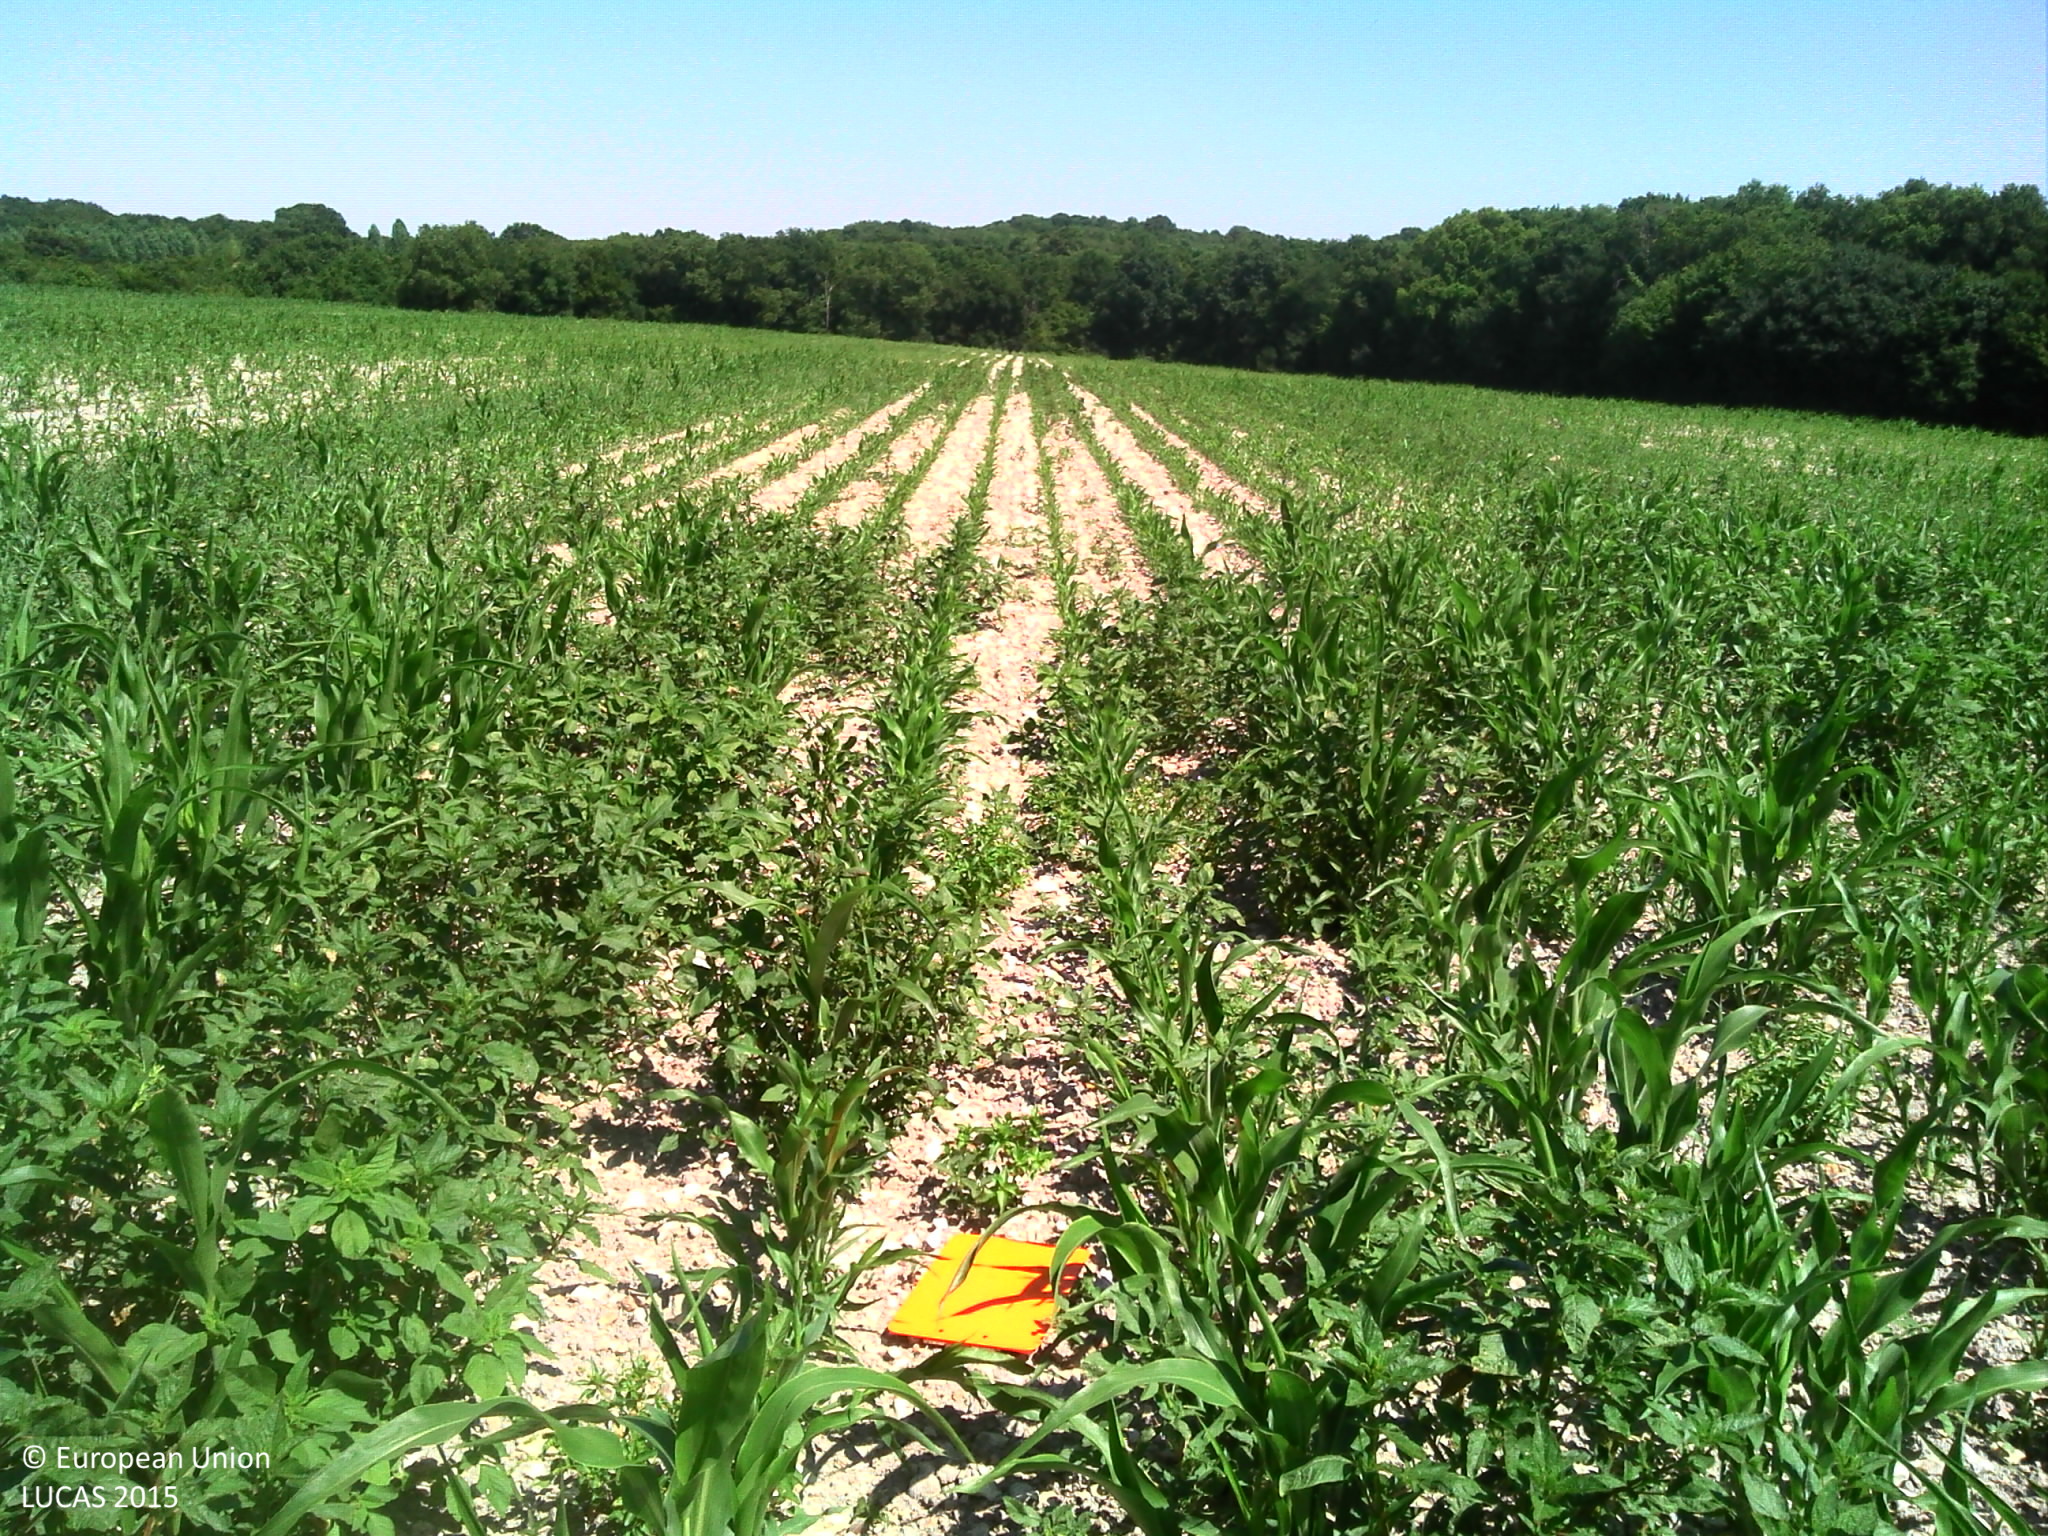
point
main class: Cropland
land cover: Maize
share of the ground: 25 - 50 %
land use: Agriculture (excluding fallow land and kitchen gardens)
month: July
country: FR
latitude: 47.2357
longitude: 0.5353
